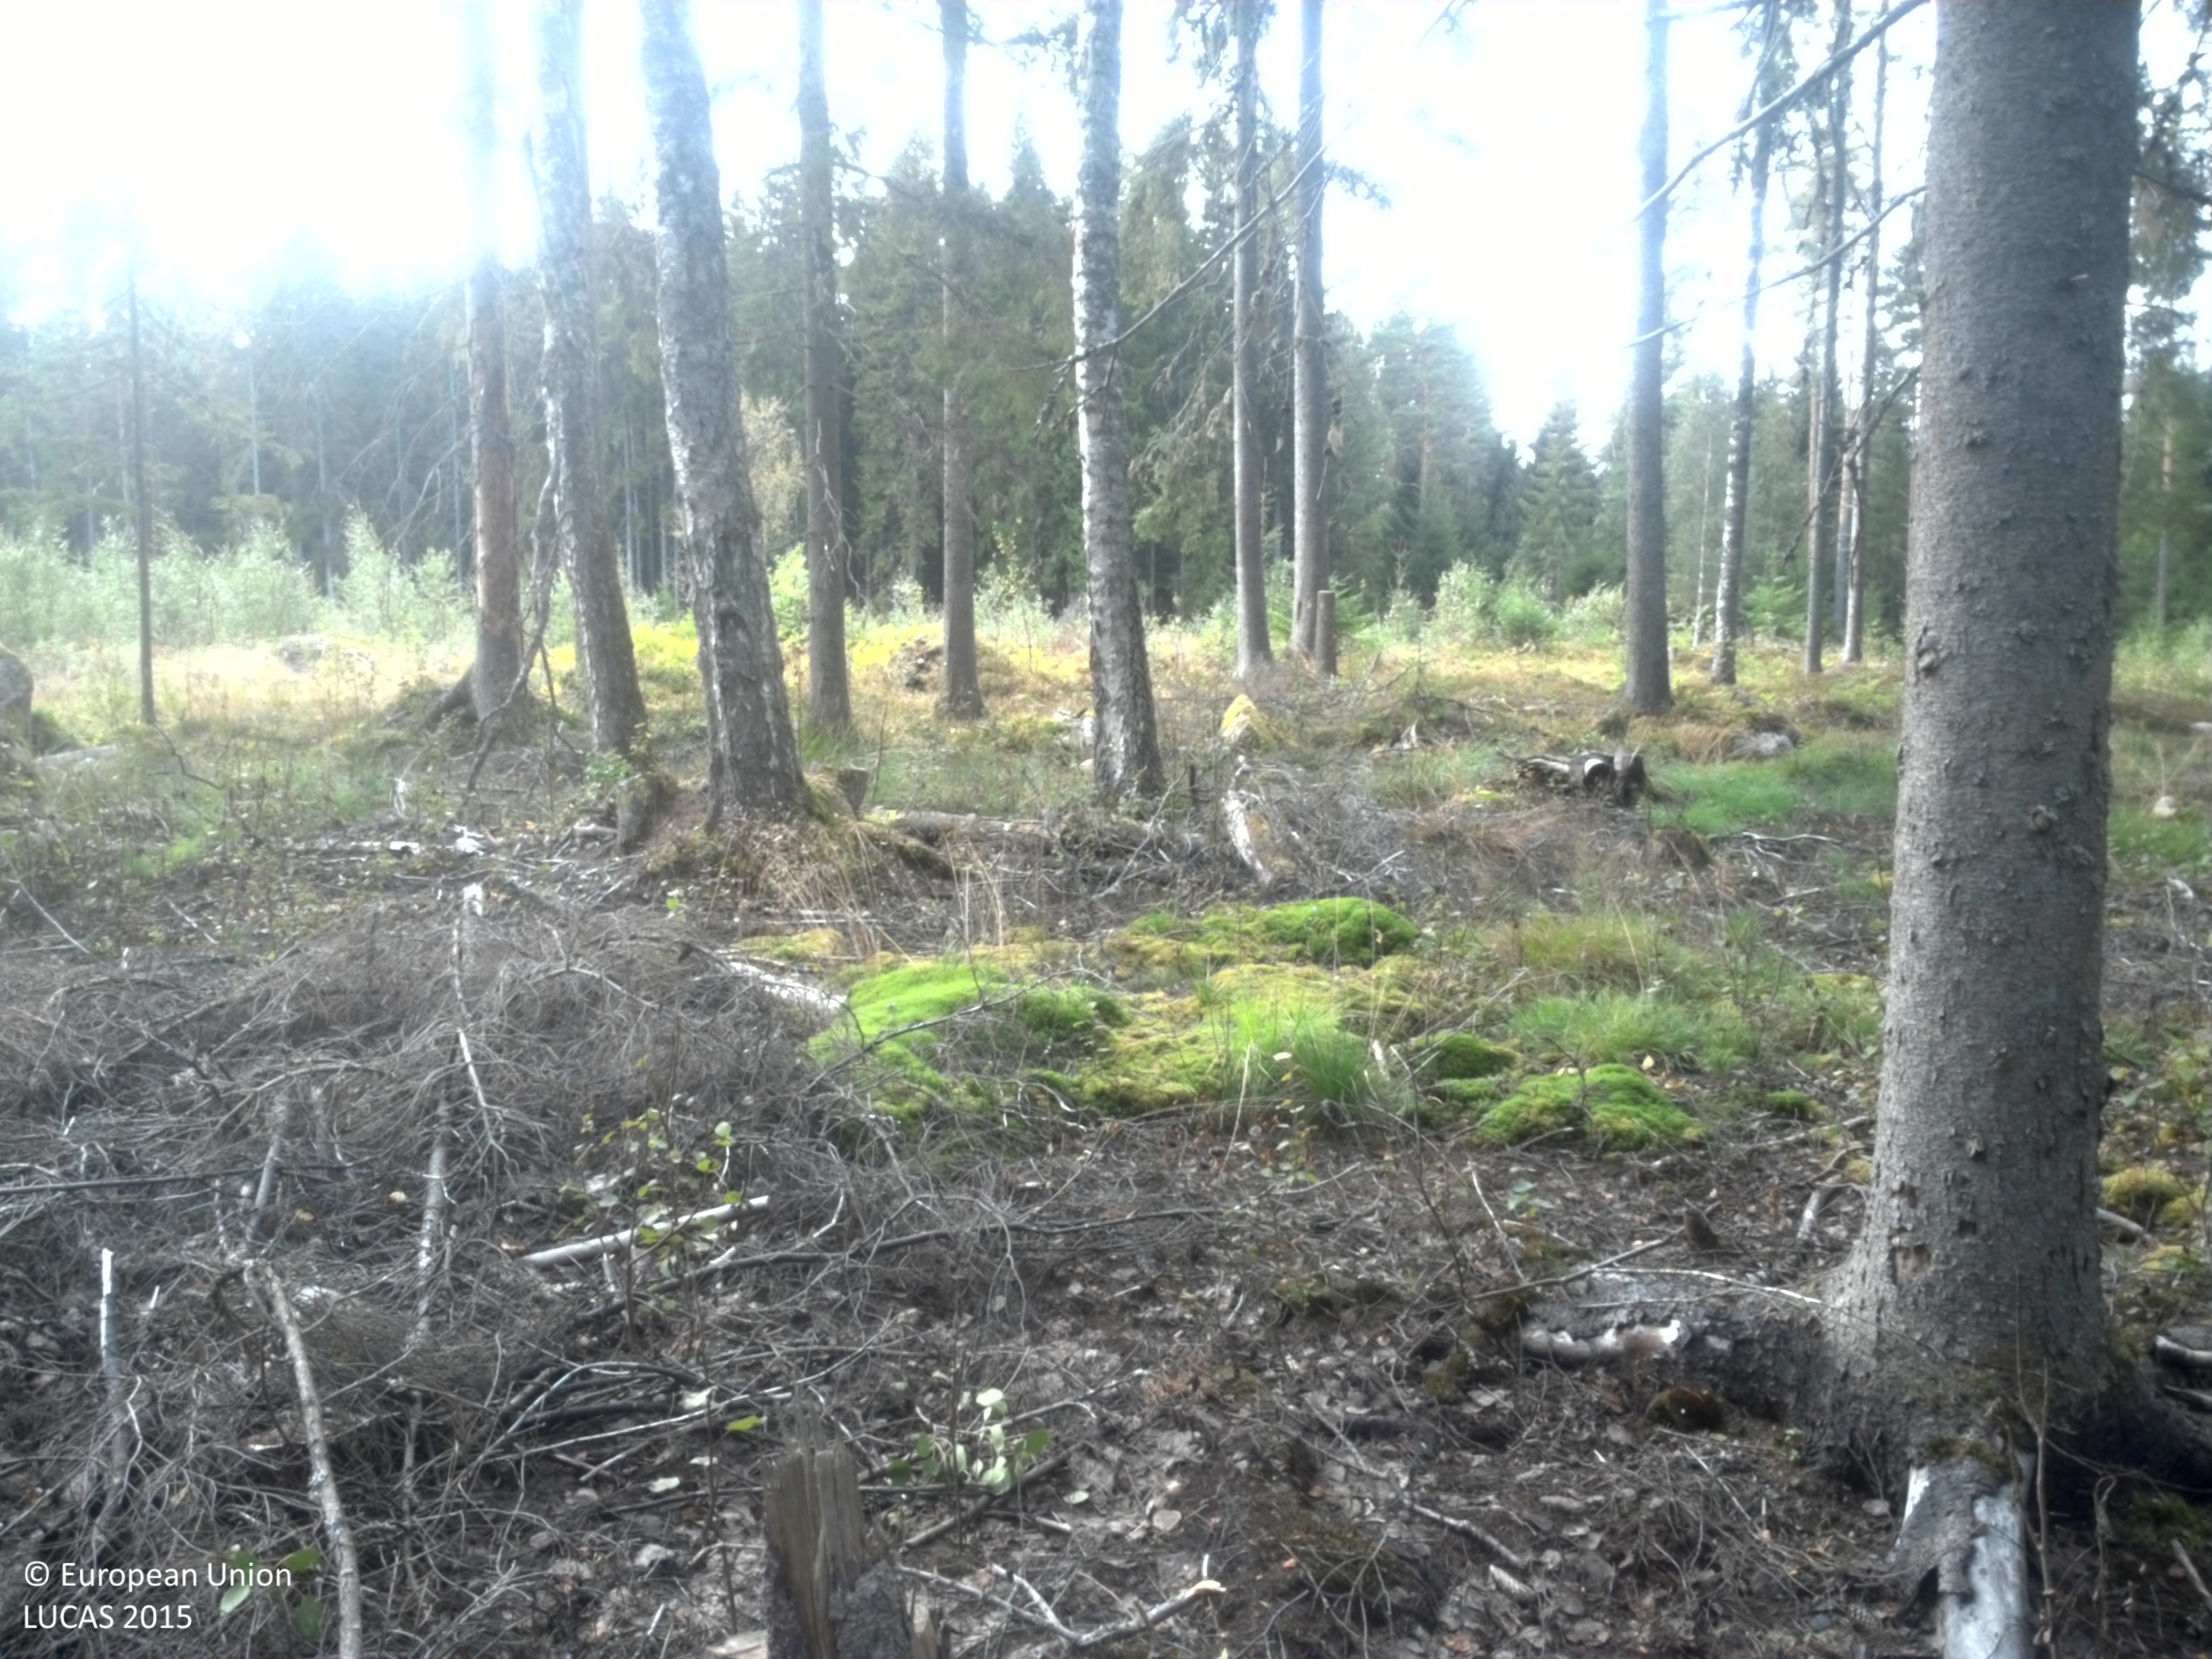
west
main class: Woodland
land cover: Spruce dominated mixed woodland
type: boreal forest
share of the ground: 50 - 75 %
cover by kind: coniferous forest trees 45 %, broadleaved forest trees 15 %, lichens and mosses 15 %, shrubs 10 %, herbaceous plants 10 %, unconsolidated bare surface 5 %
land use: Forestry
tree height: > 5 m
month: September
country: SE
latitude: 59.5075
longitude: 15.6627
